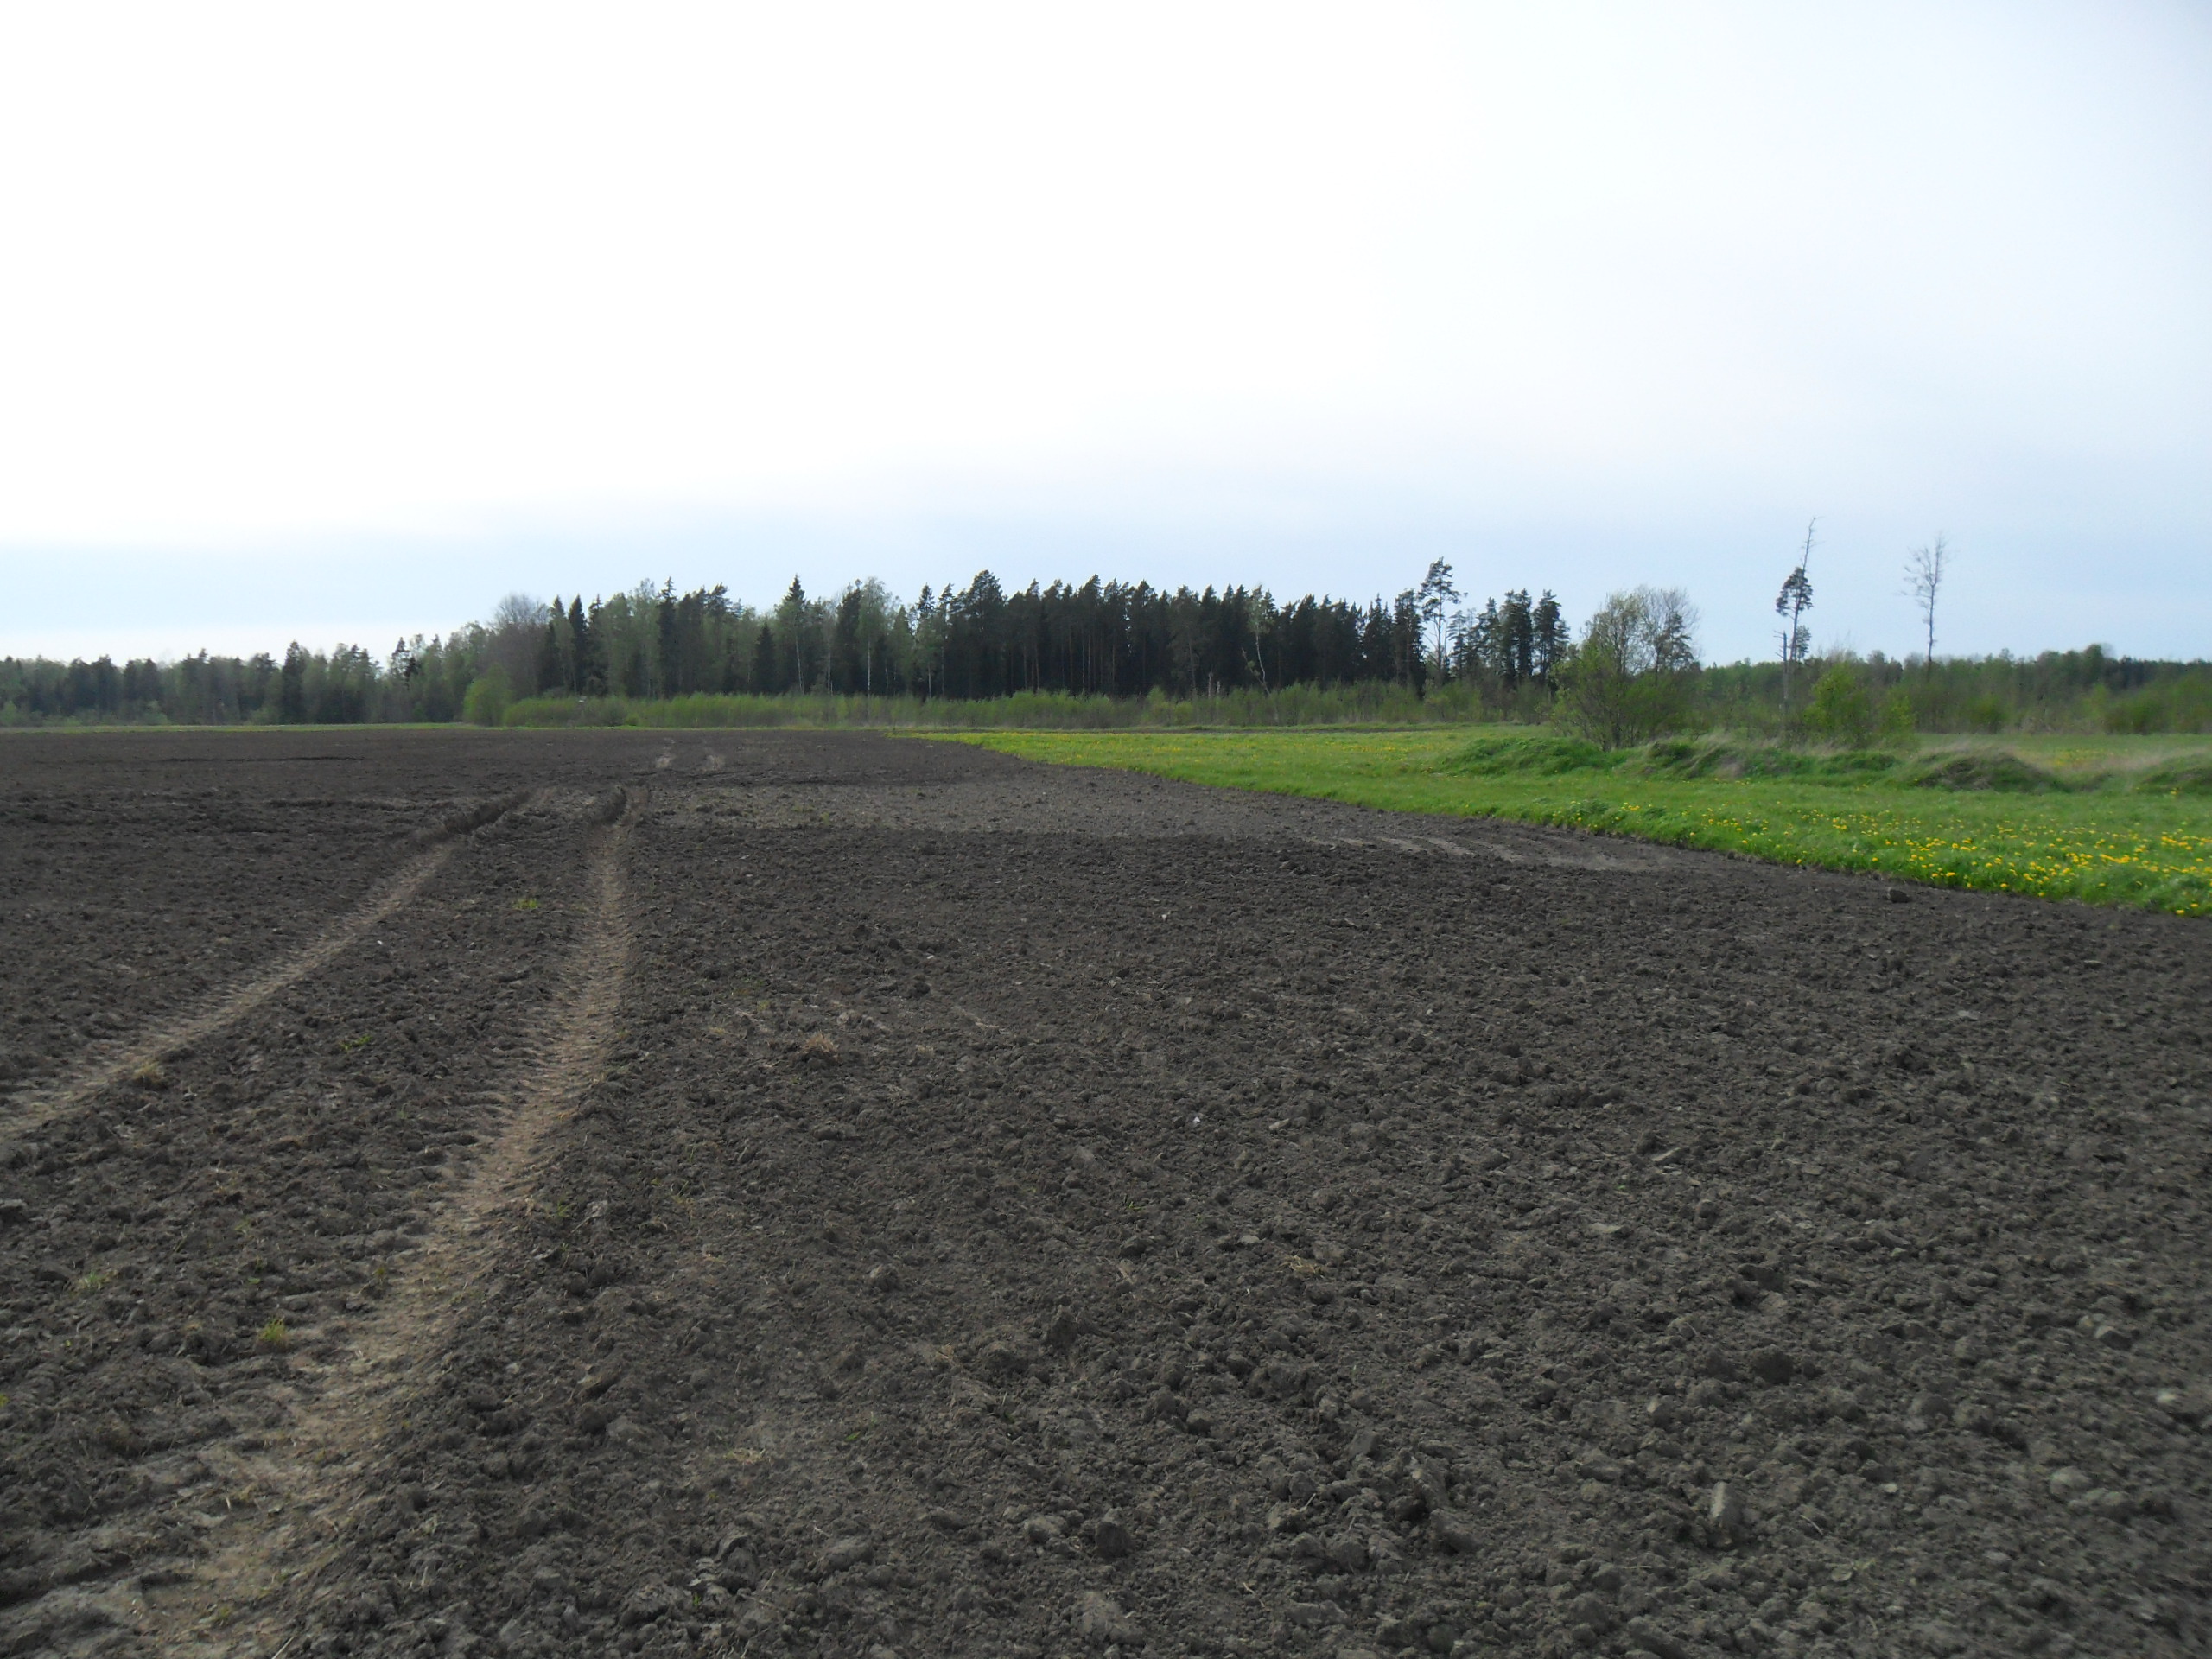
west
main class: Cropland
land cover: Rape and turnip rape
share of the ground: < 10 %
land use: Agriculture (excluding fallow land and kitchen gardens)
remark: Tilled/Sowed
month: May
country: LV
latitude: 57.2728
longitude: 23.0149
